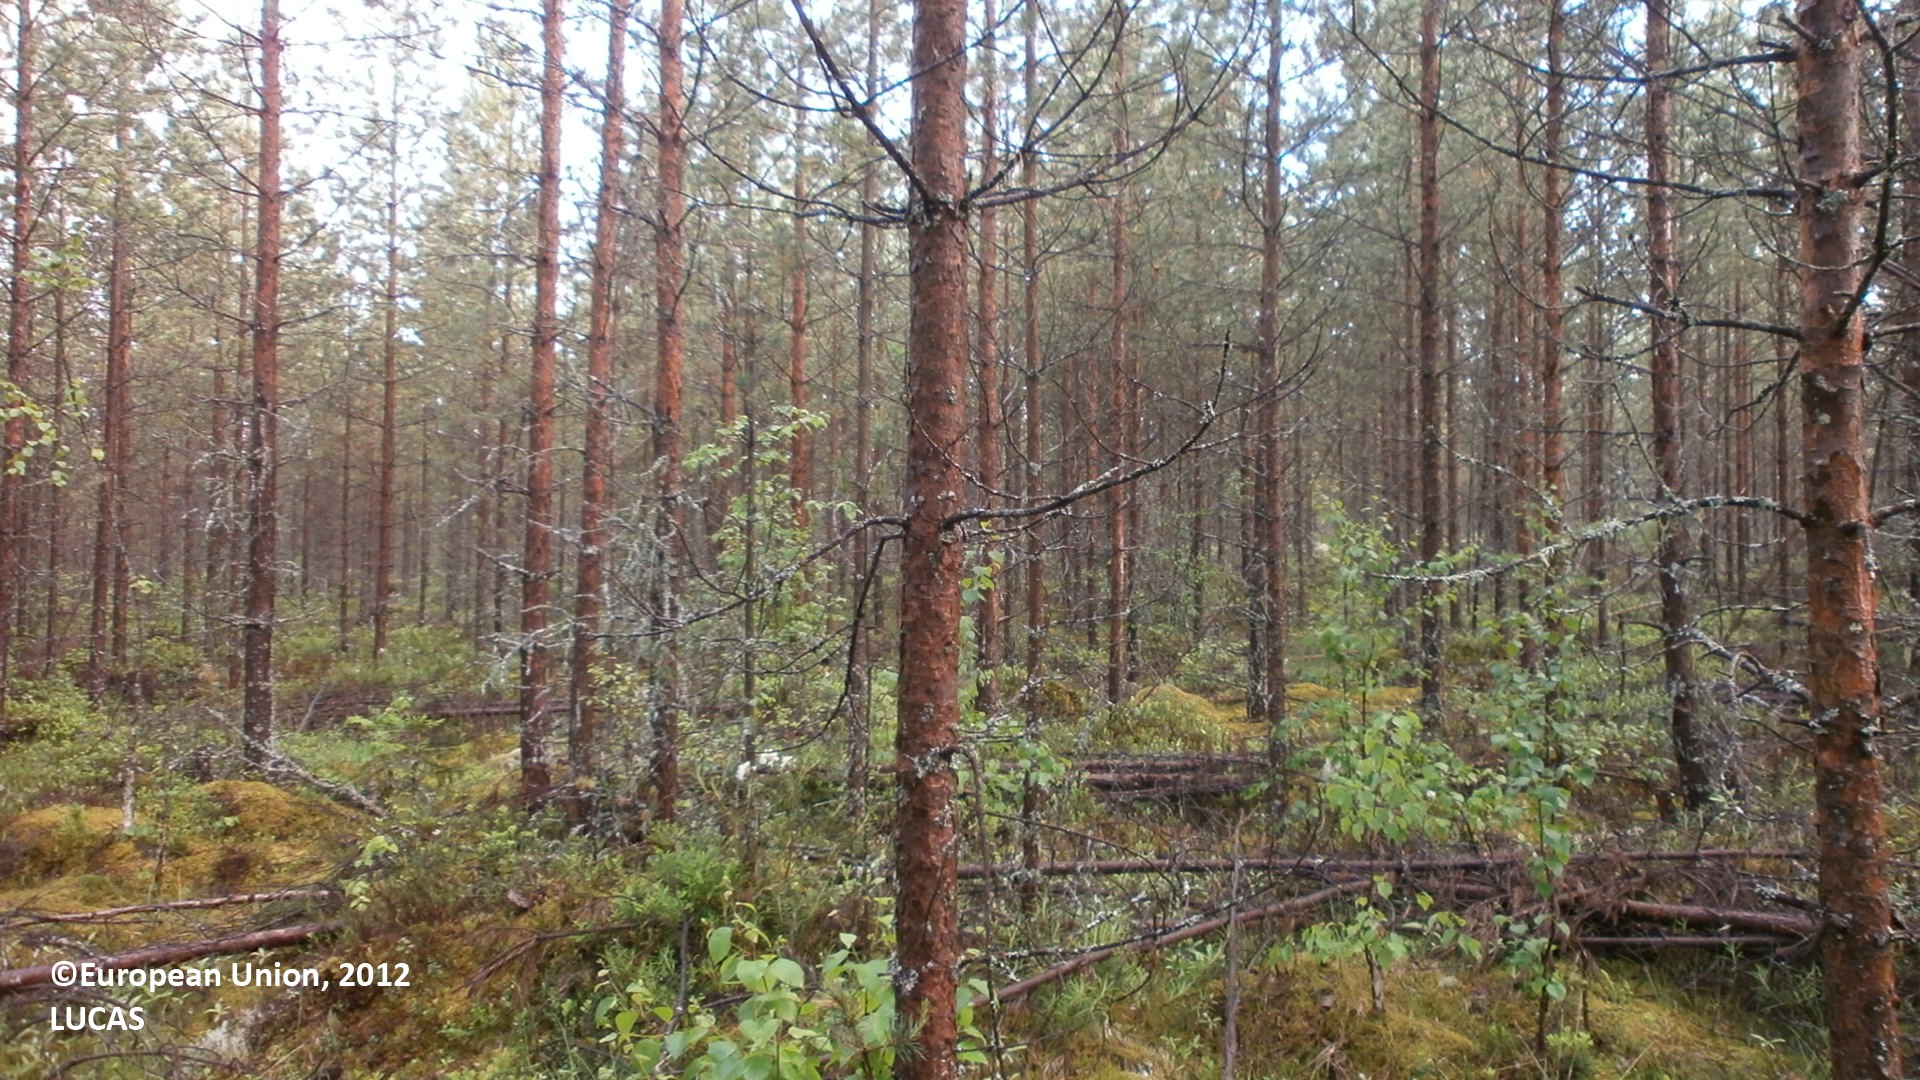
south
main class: Woodland
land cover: Pine dominated coniferous woodland
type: mire and swamp forests
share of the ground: 50 - 75 %
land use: Forestry
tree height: > 5 m
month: June
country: FI
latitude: 64.8075
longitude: 25.1758
